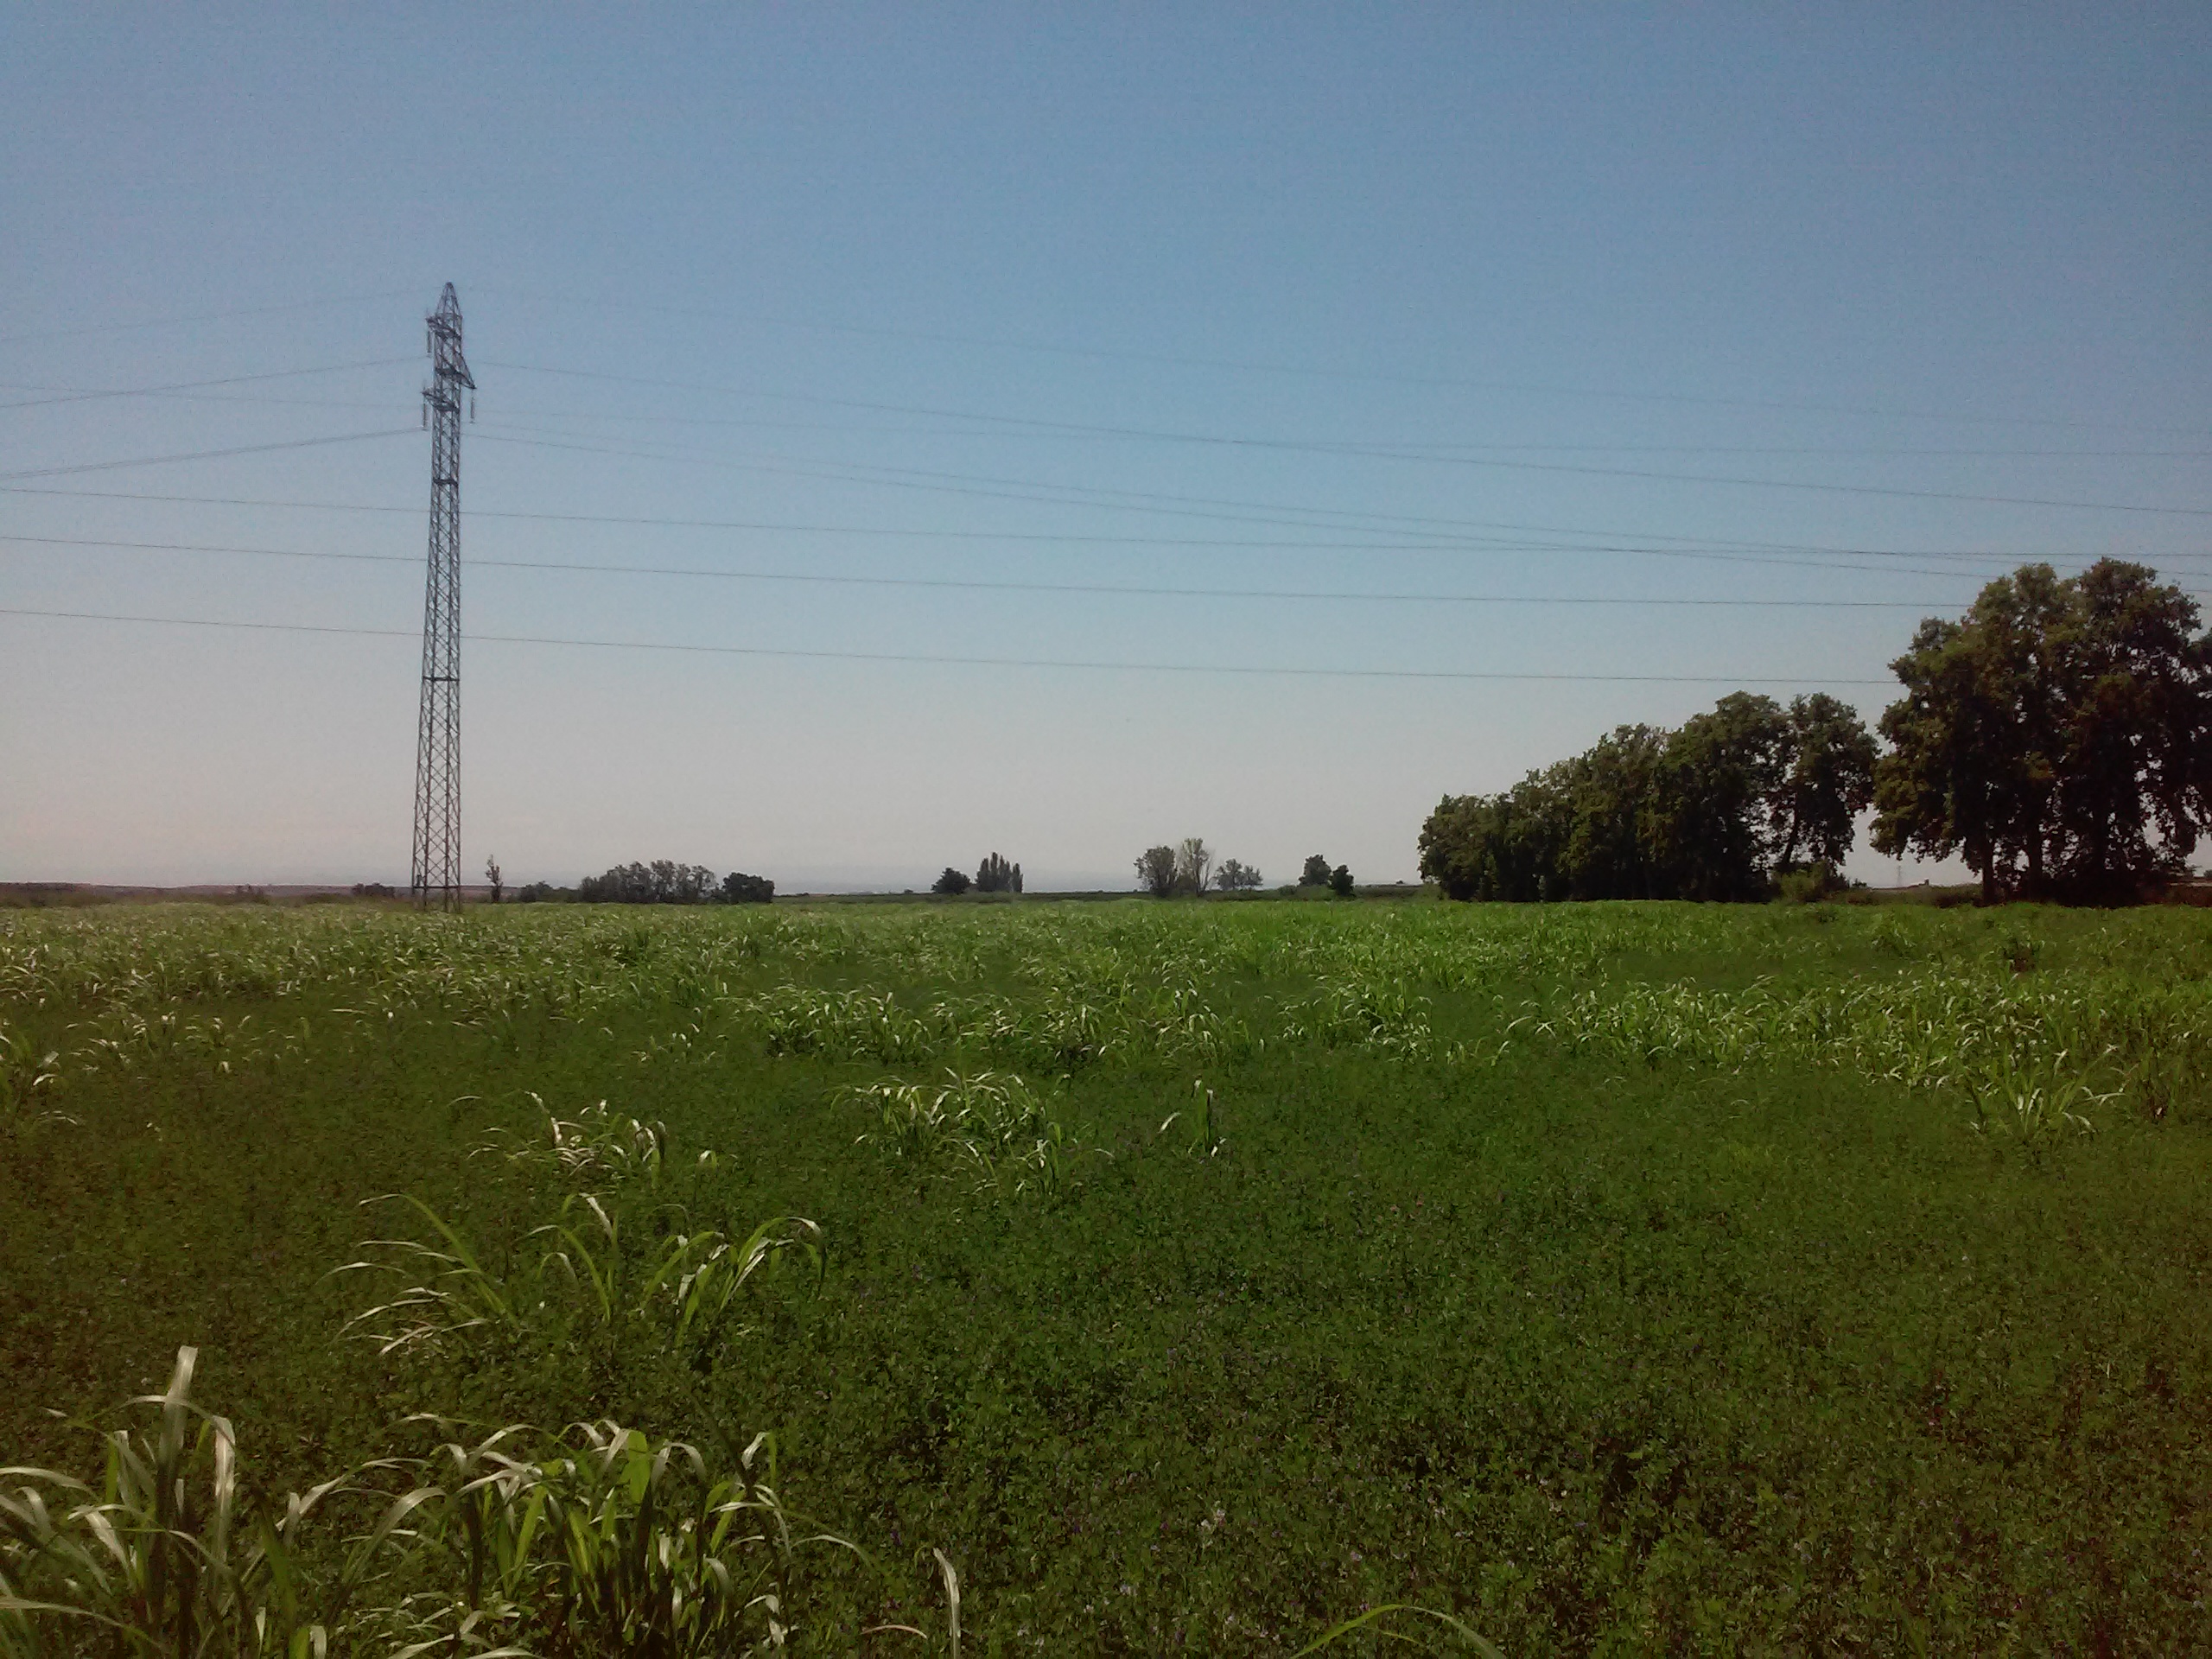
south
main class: Cropland
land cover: Lucerne
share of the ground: 50 - 75 %
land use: Agriculture (excluding fallow land and kitchen gardens)
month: July
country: ES
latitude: 41.7117
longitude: 0.6485
